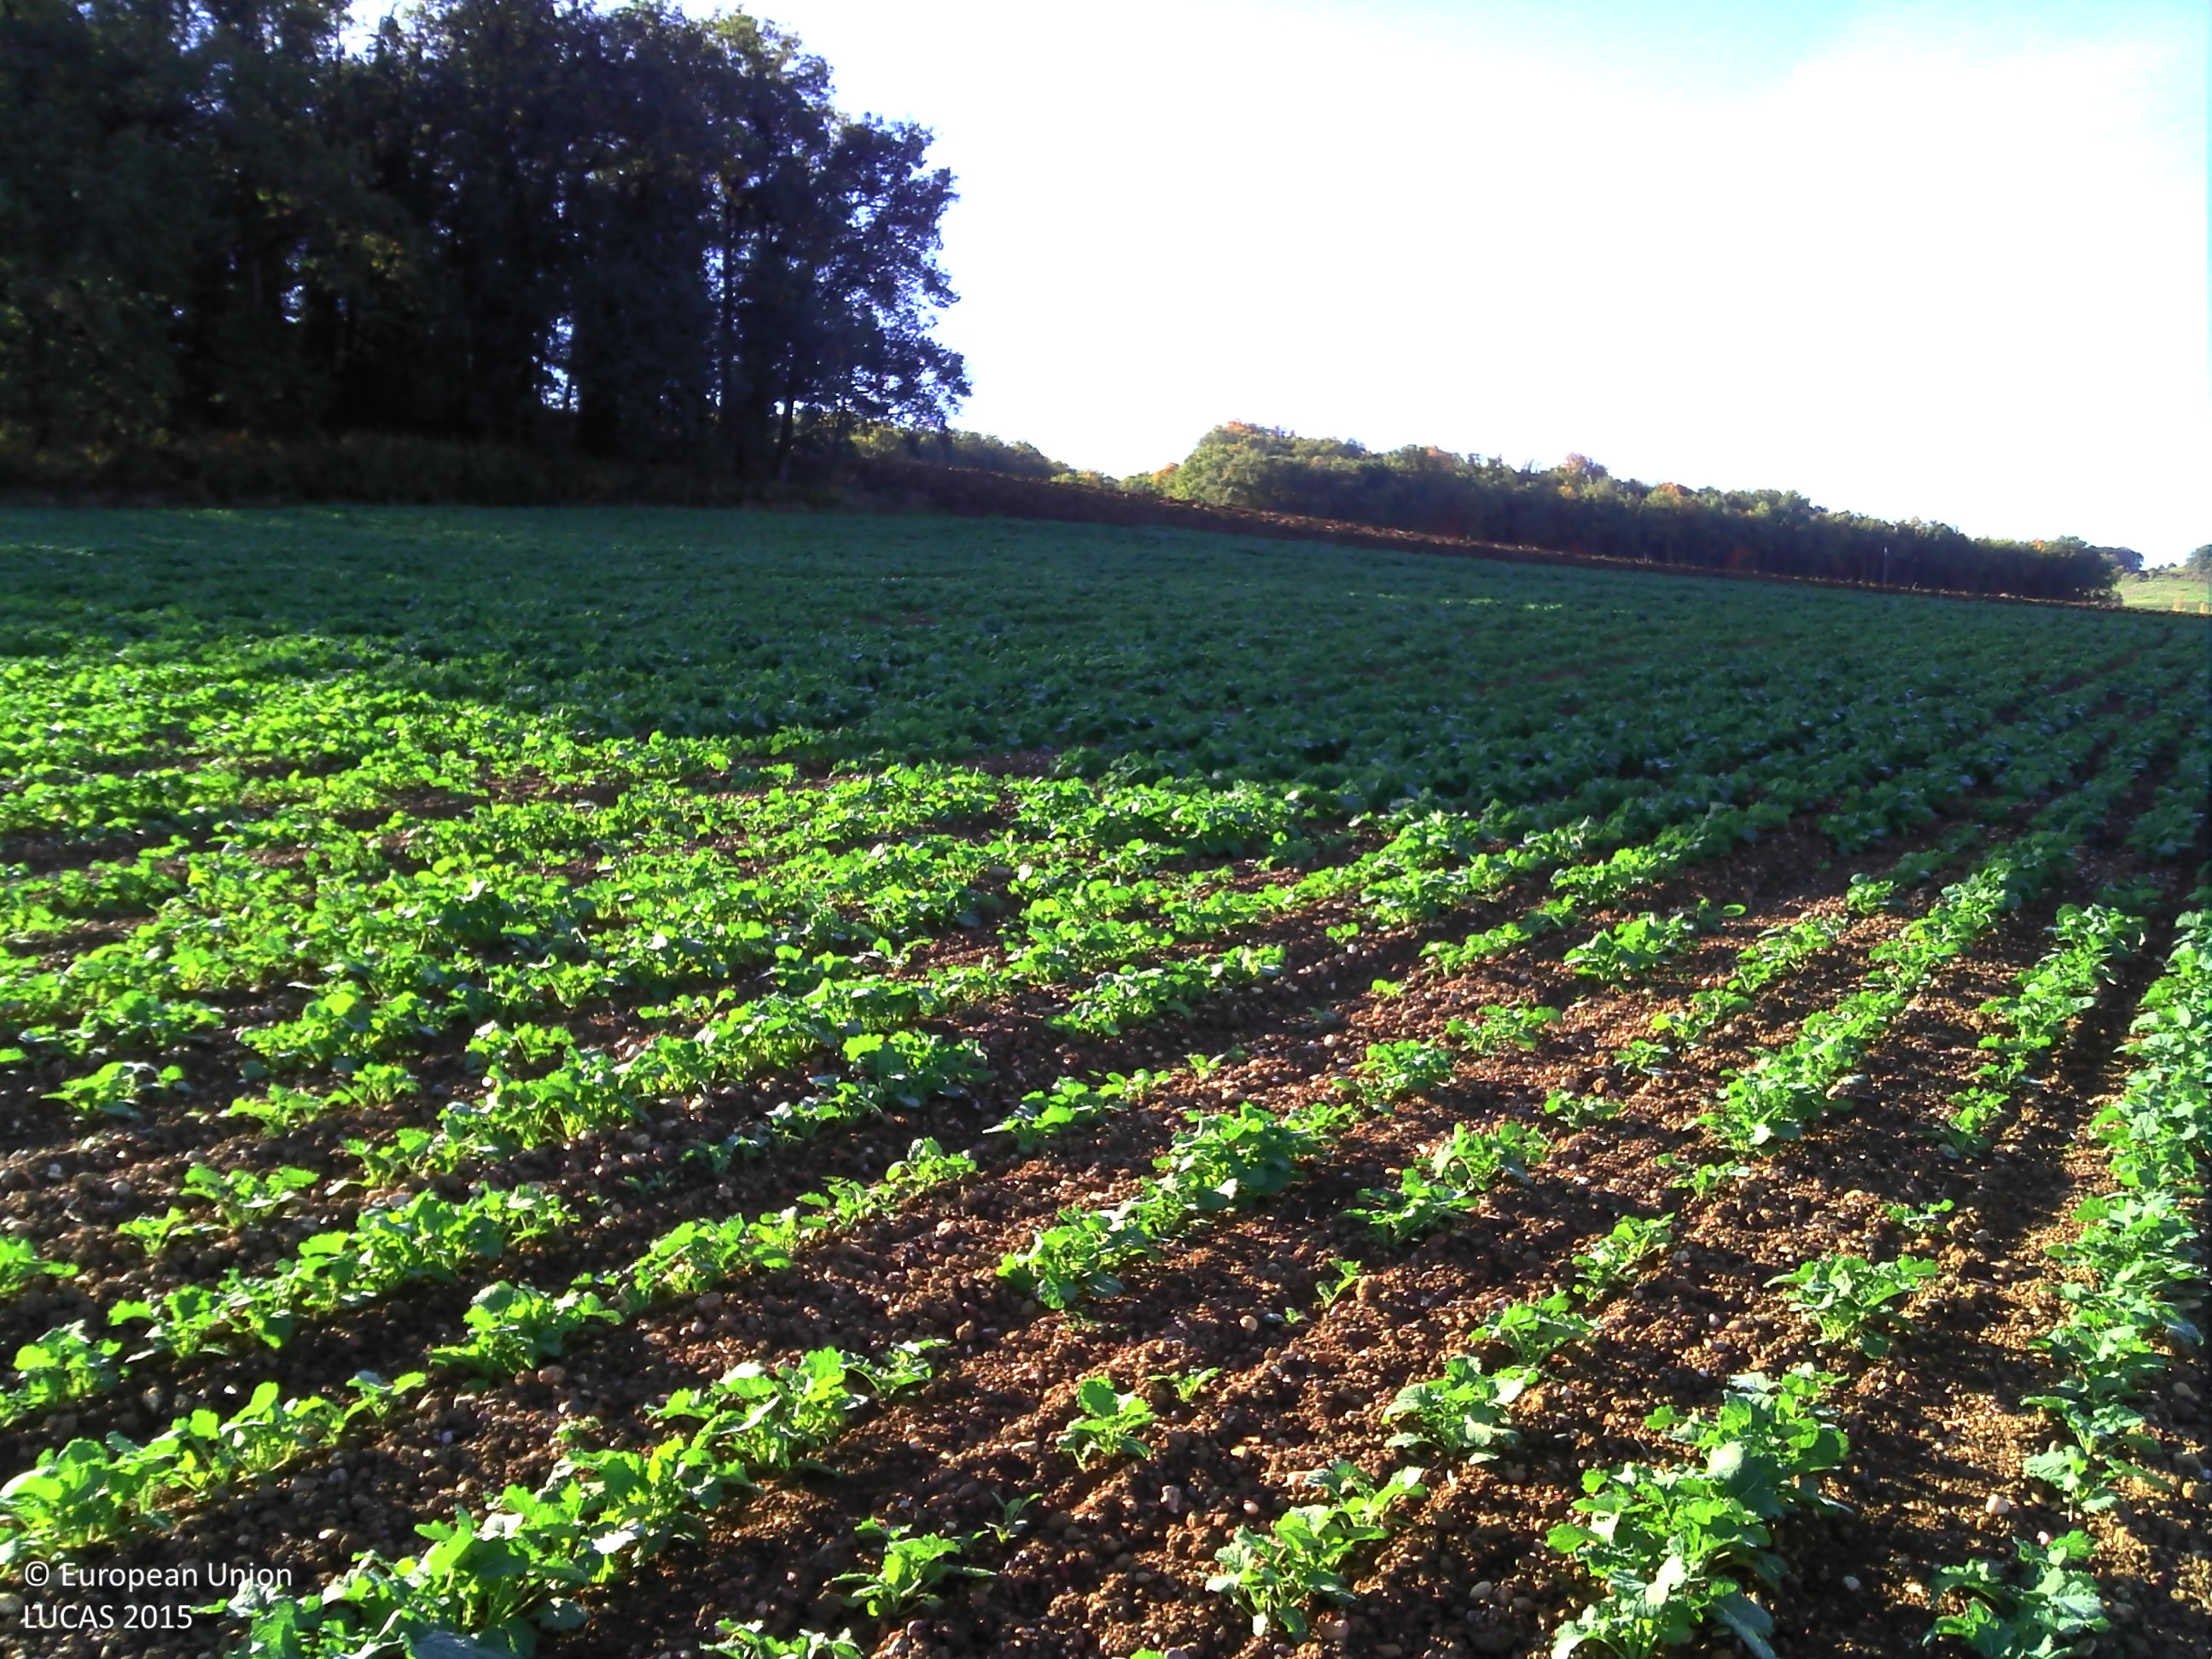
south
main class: Cropland
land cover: Rape and turnip rape
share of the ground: 25 - 50 %
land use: Agriculture (excluding fallow land and kitchen gardens)
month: October
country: FR
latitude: 43.9556
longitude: 0.9635
